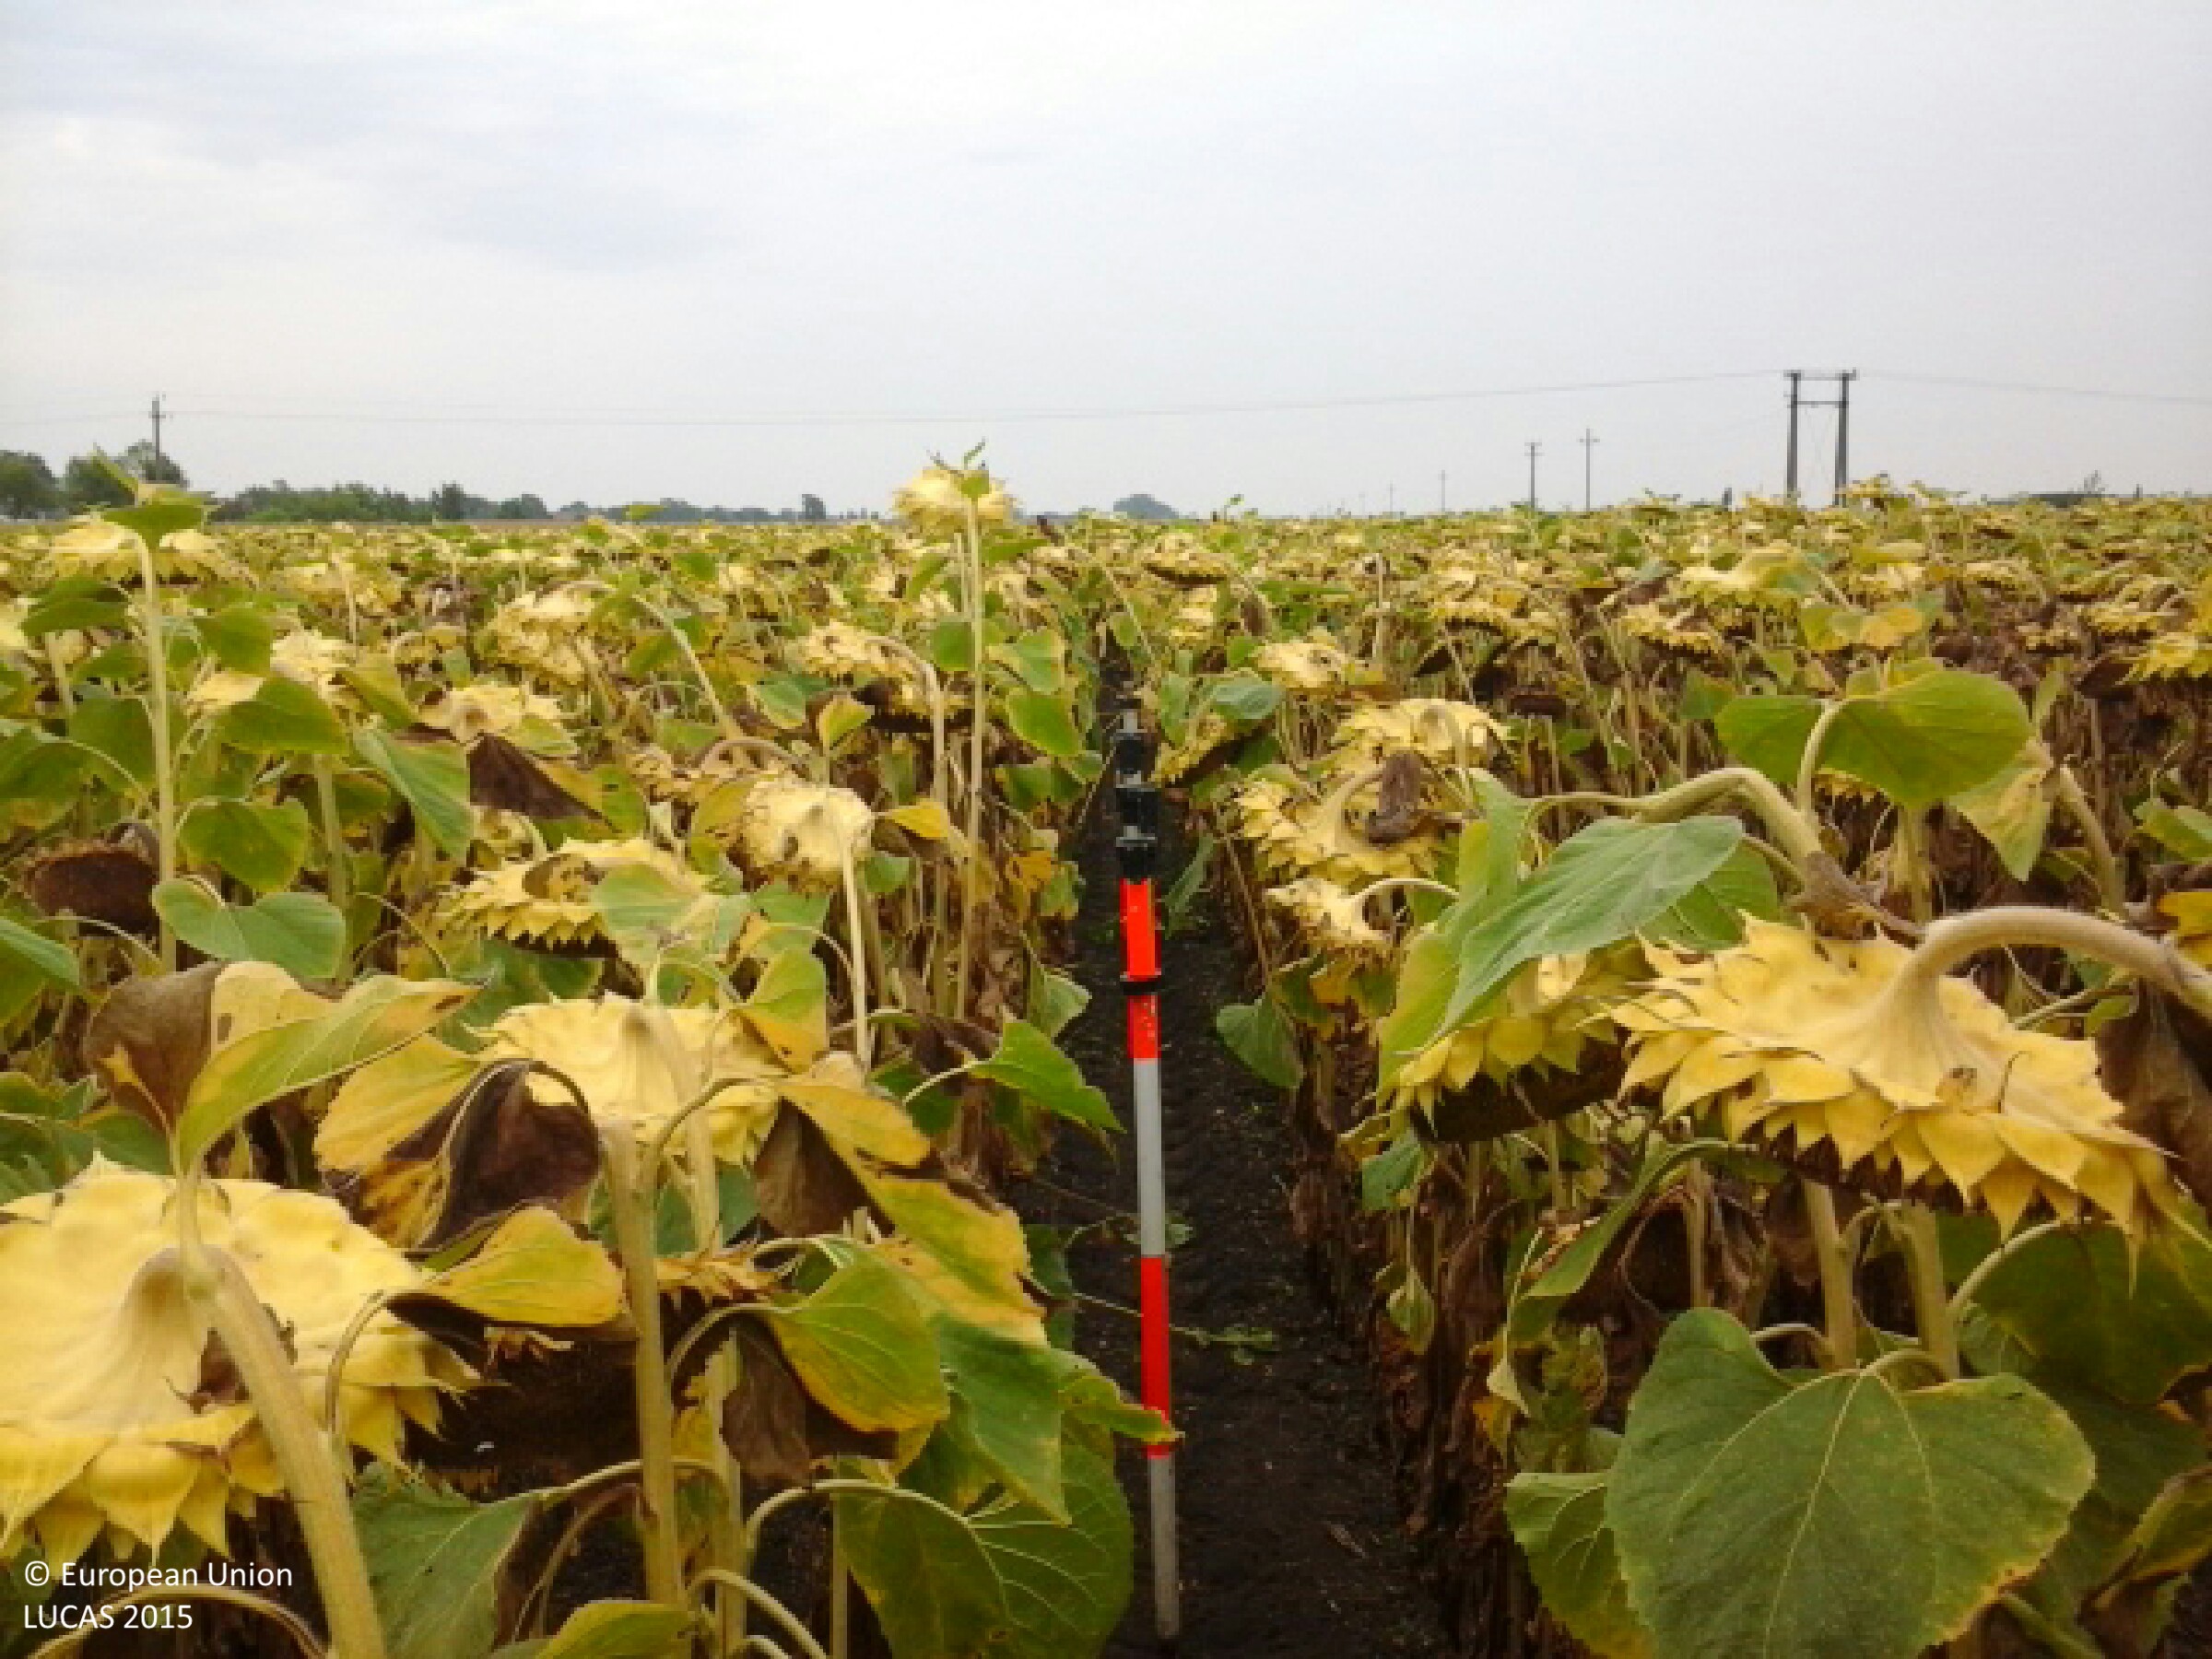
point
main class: Cropland
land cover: Sunflower
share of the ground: > 75 %
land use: Agriculture (excluding fallow land and kitchen gardens)
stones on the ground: < 10 %
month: August
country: HU
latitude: 47.1896
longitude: 21.7778
